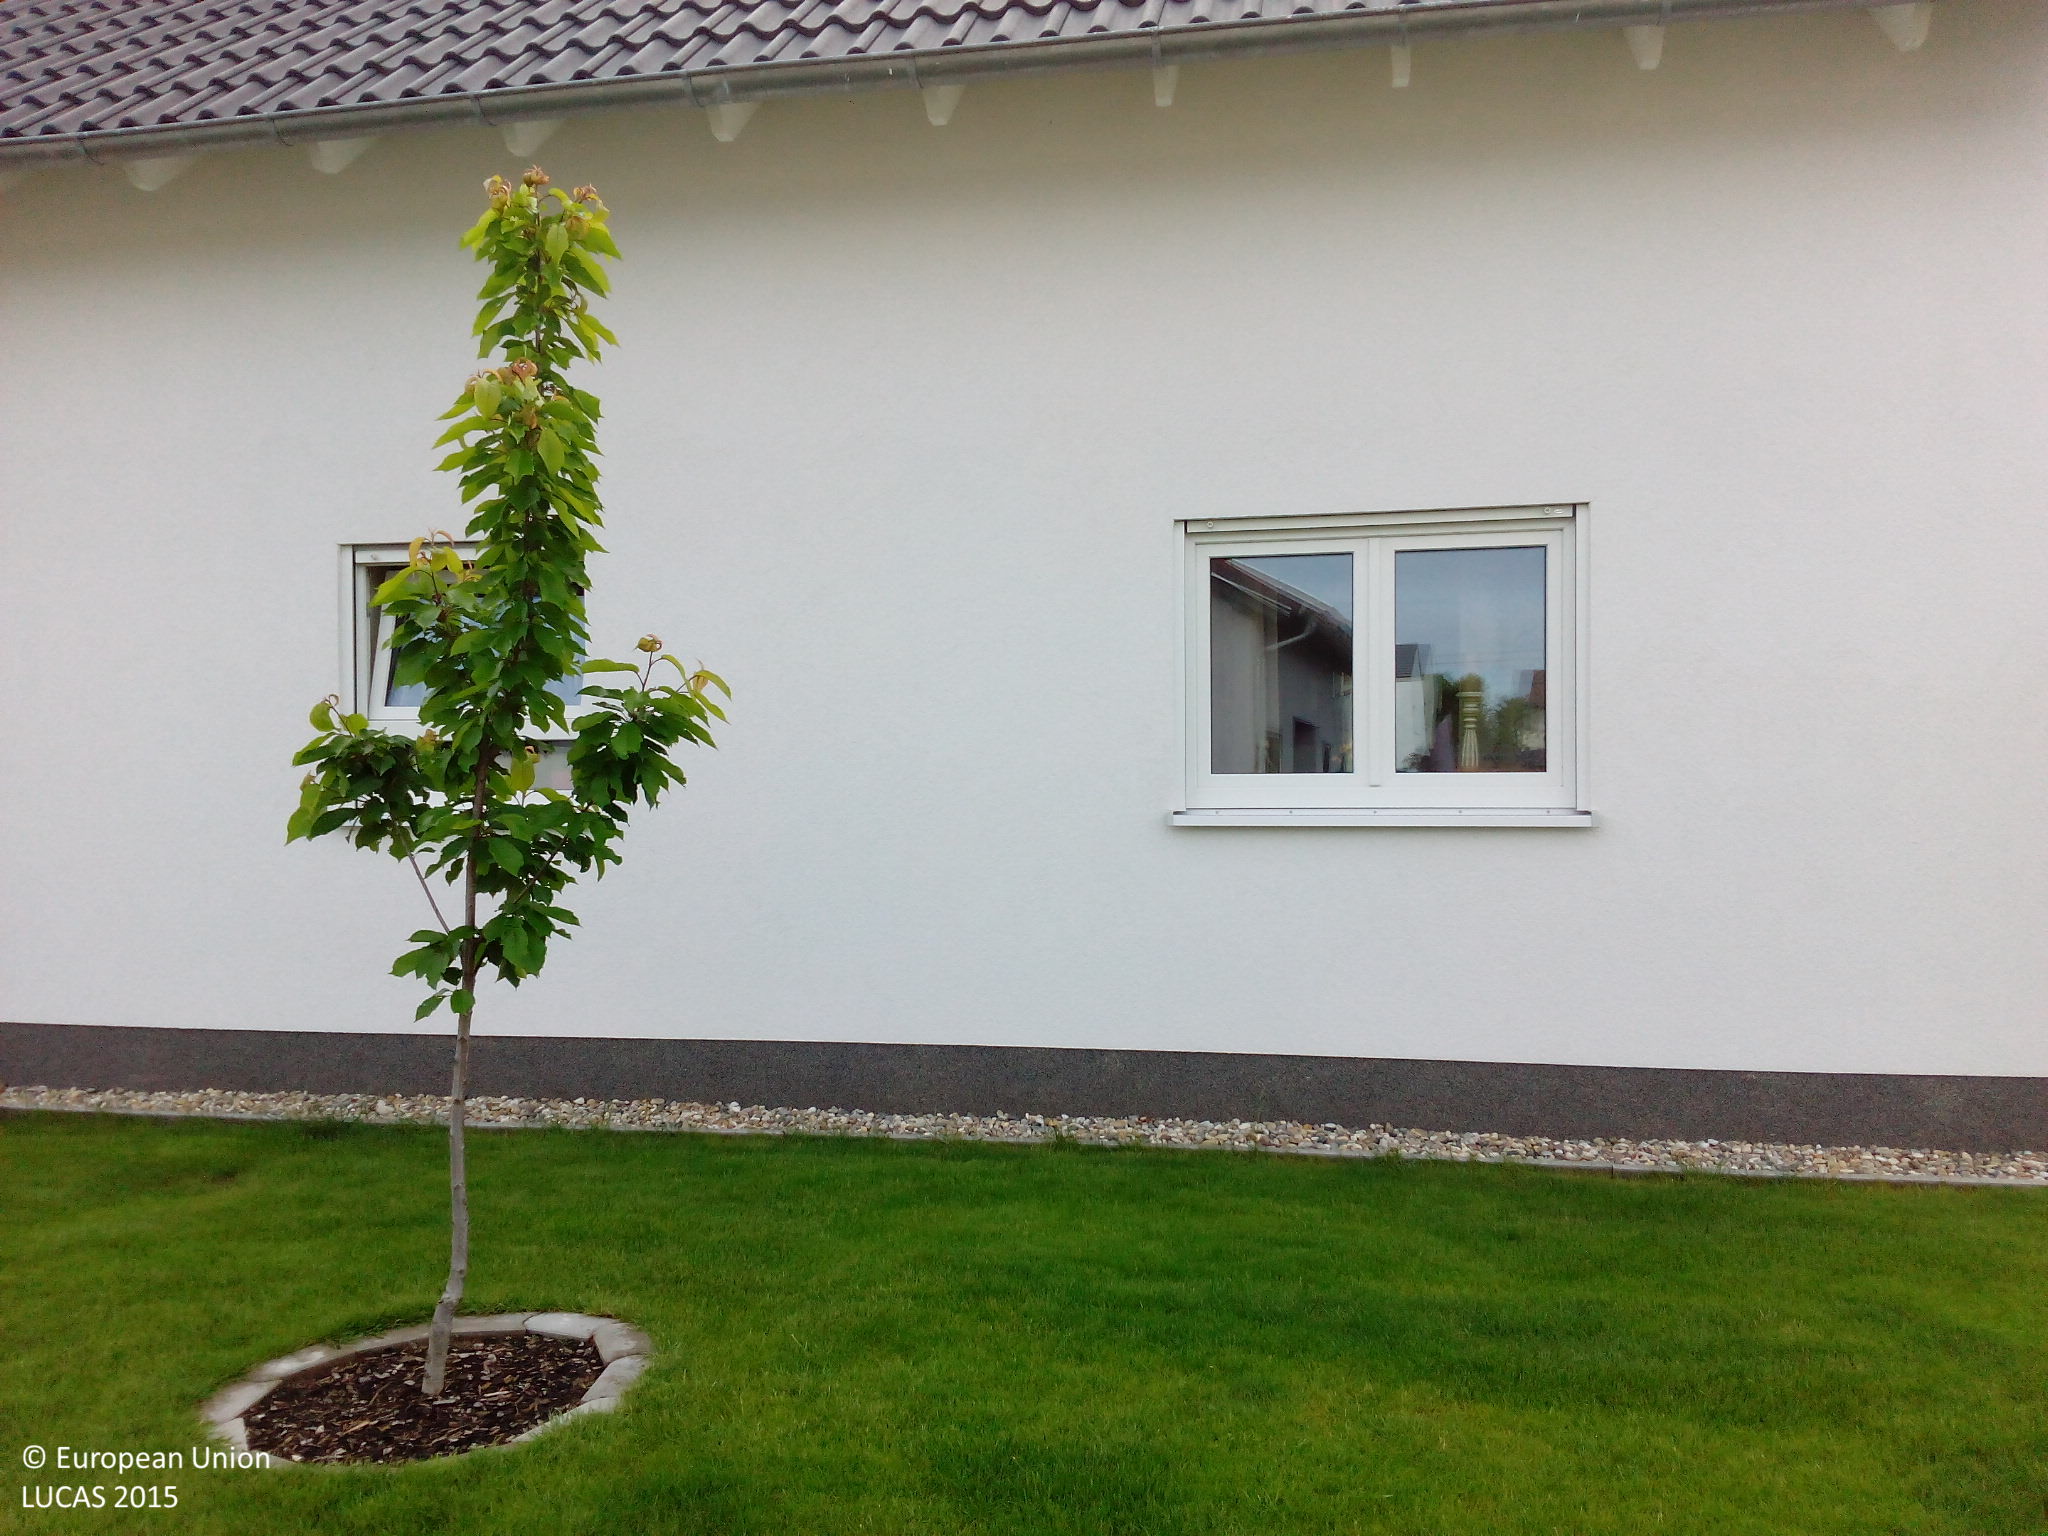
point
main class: Grassland
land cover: Grassland without tree/shrub cover
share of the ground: > 75 %
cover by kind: herbaceous plants 95 %, unconsolidated bare surface 5 %
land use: Residential
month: May
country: DE
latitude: 49.0719
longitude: 8.1526
